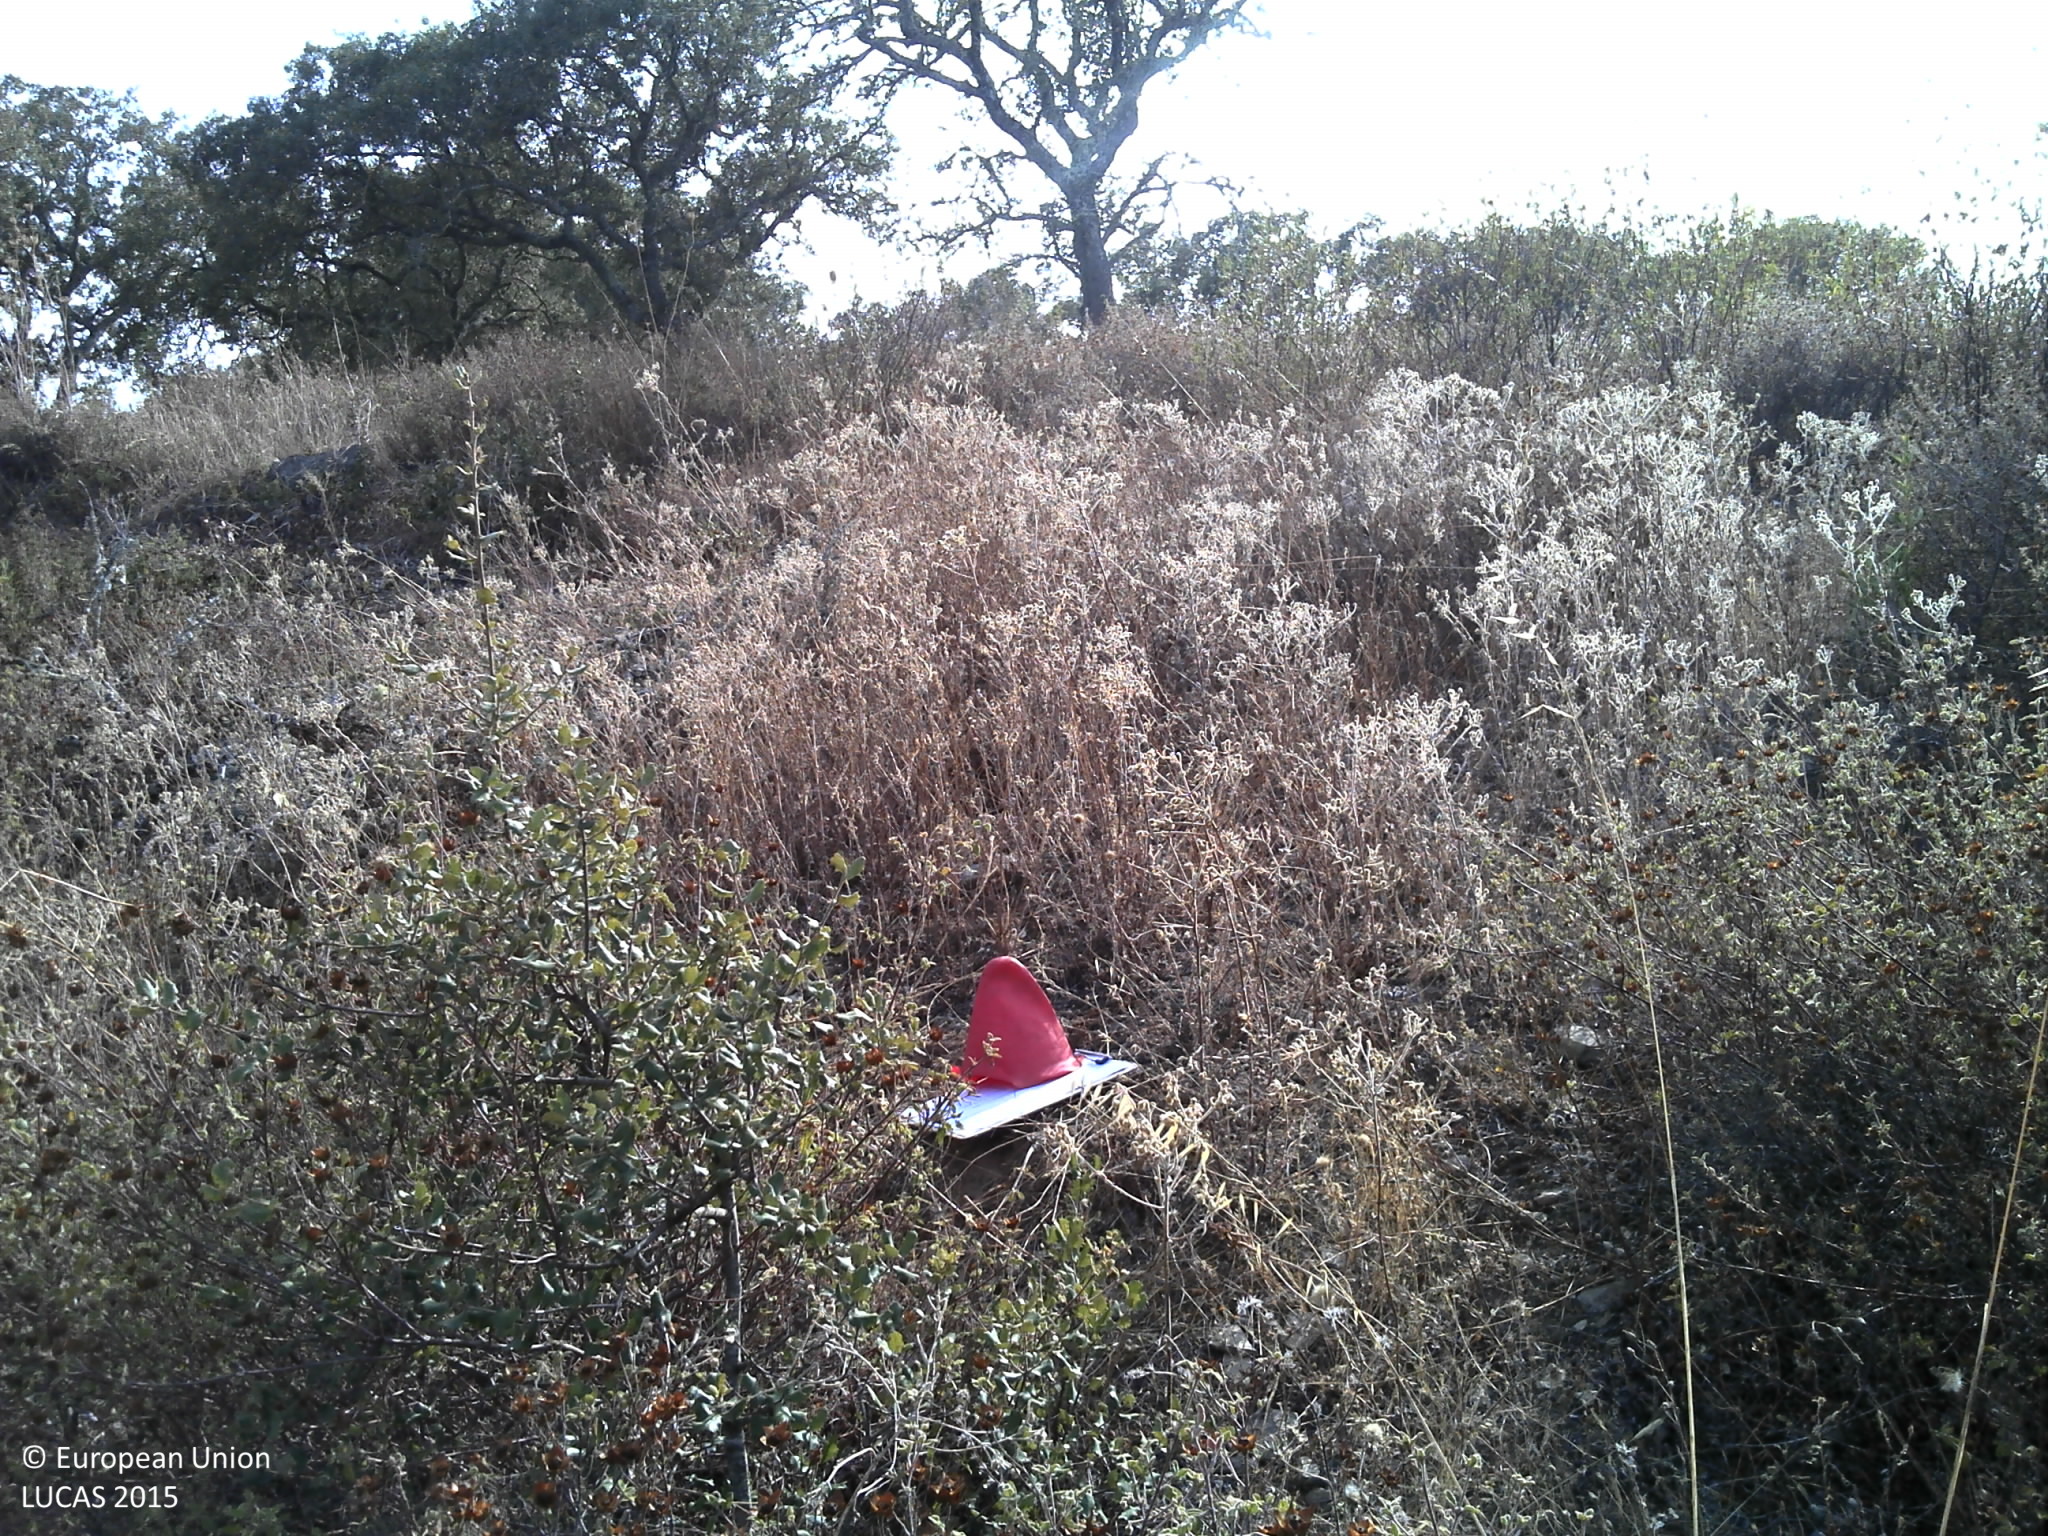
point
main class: Grassland
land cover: Grassland with sparse tree/shrub cover
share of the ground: > 75 %
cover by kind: herbaceous plants 80 %, consolidated bare surface 15 %, broadleaved forest trees 5 %
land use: Agriculture (excluding fallow land and kitchen gardens)
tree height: > 5 m
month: July
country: PT
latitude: 37.6302
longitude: -8.2613
